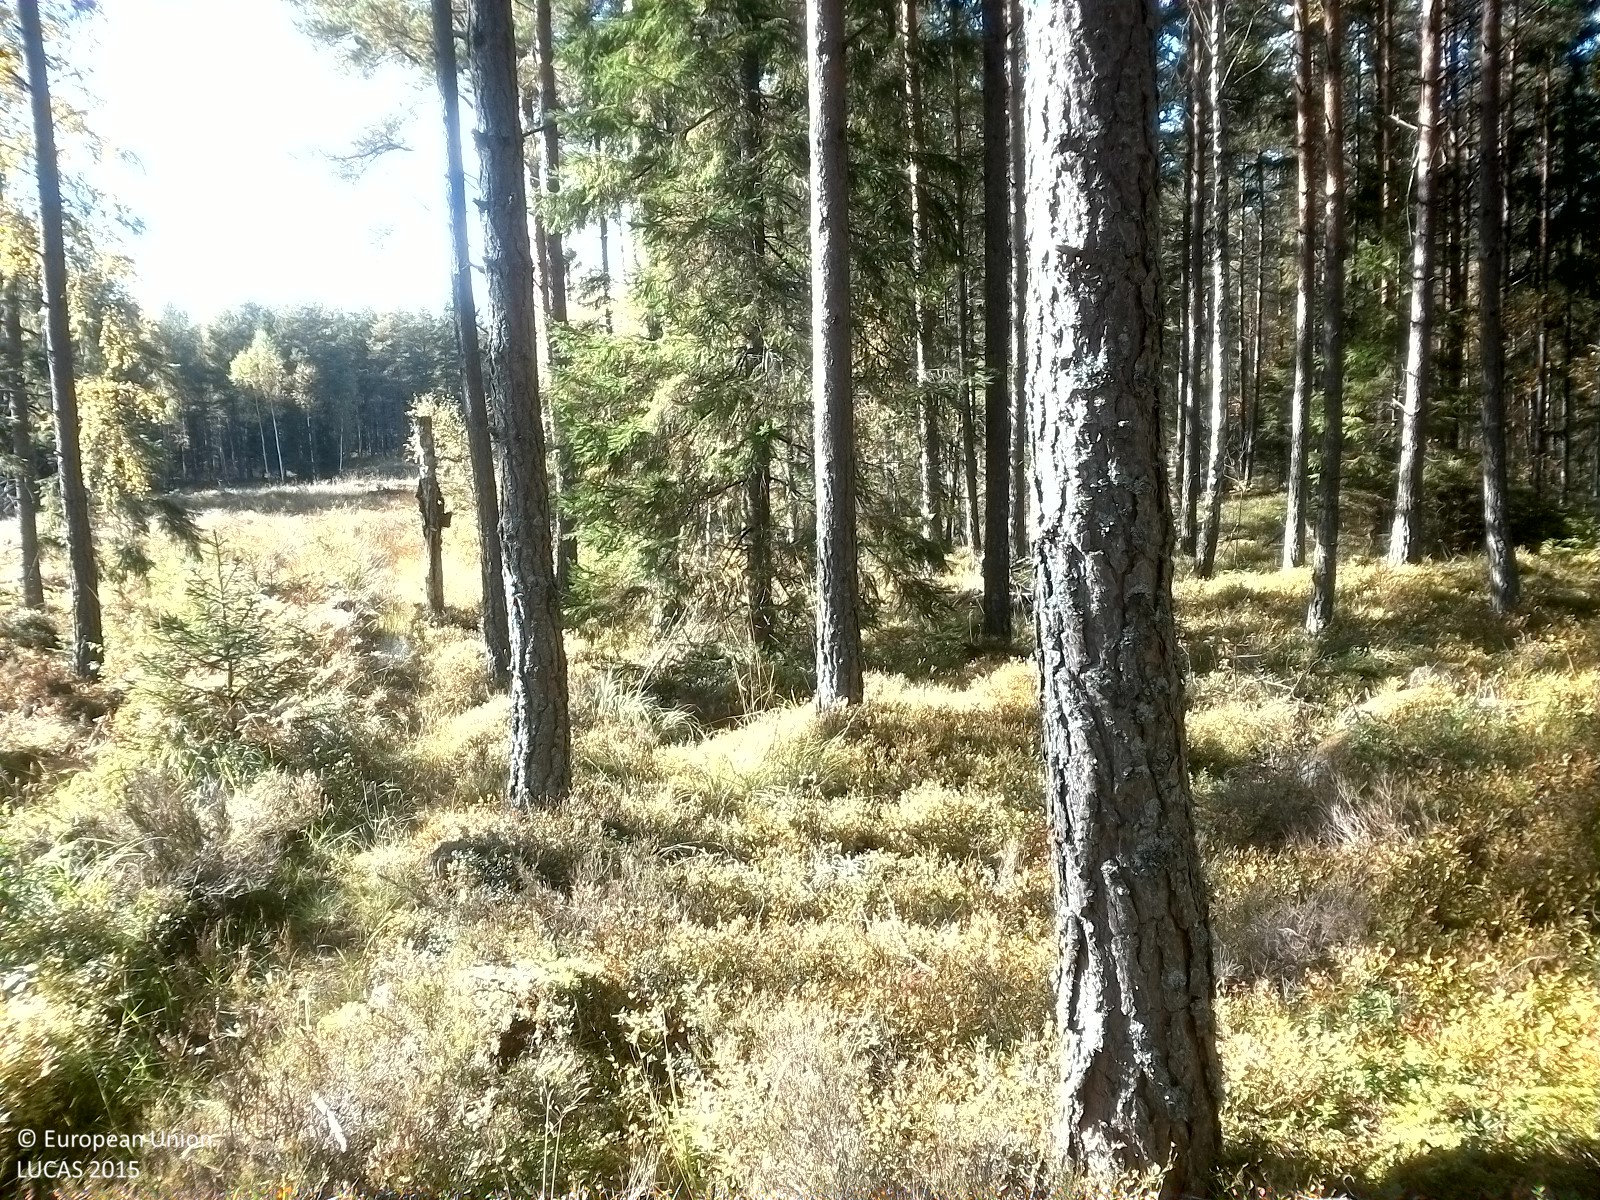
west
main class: Woodland
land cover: Pine dominated coniferous woodland
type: boreal forest
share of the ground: 25 - 50 %
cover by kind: herbaceous plants 40 %, coniferous forest trees 30 %, shrubs 15 %, lichens and mosses 10 %, broadleaved forest trees 5 %
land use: Forestry
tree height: > 5 m
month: September
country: SE
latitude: 58.6450
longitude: 16.7679
